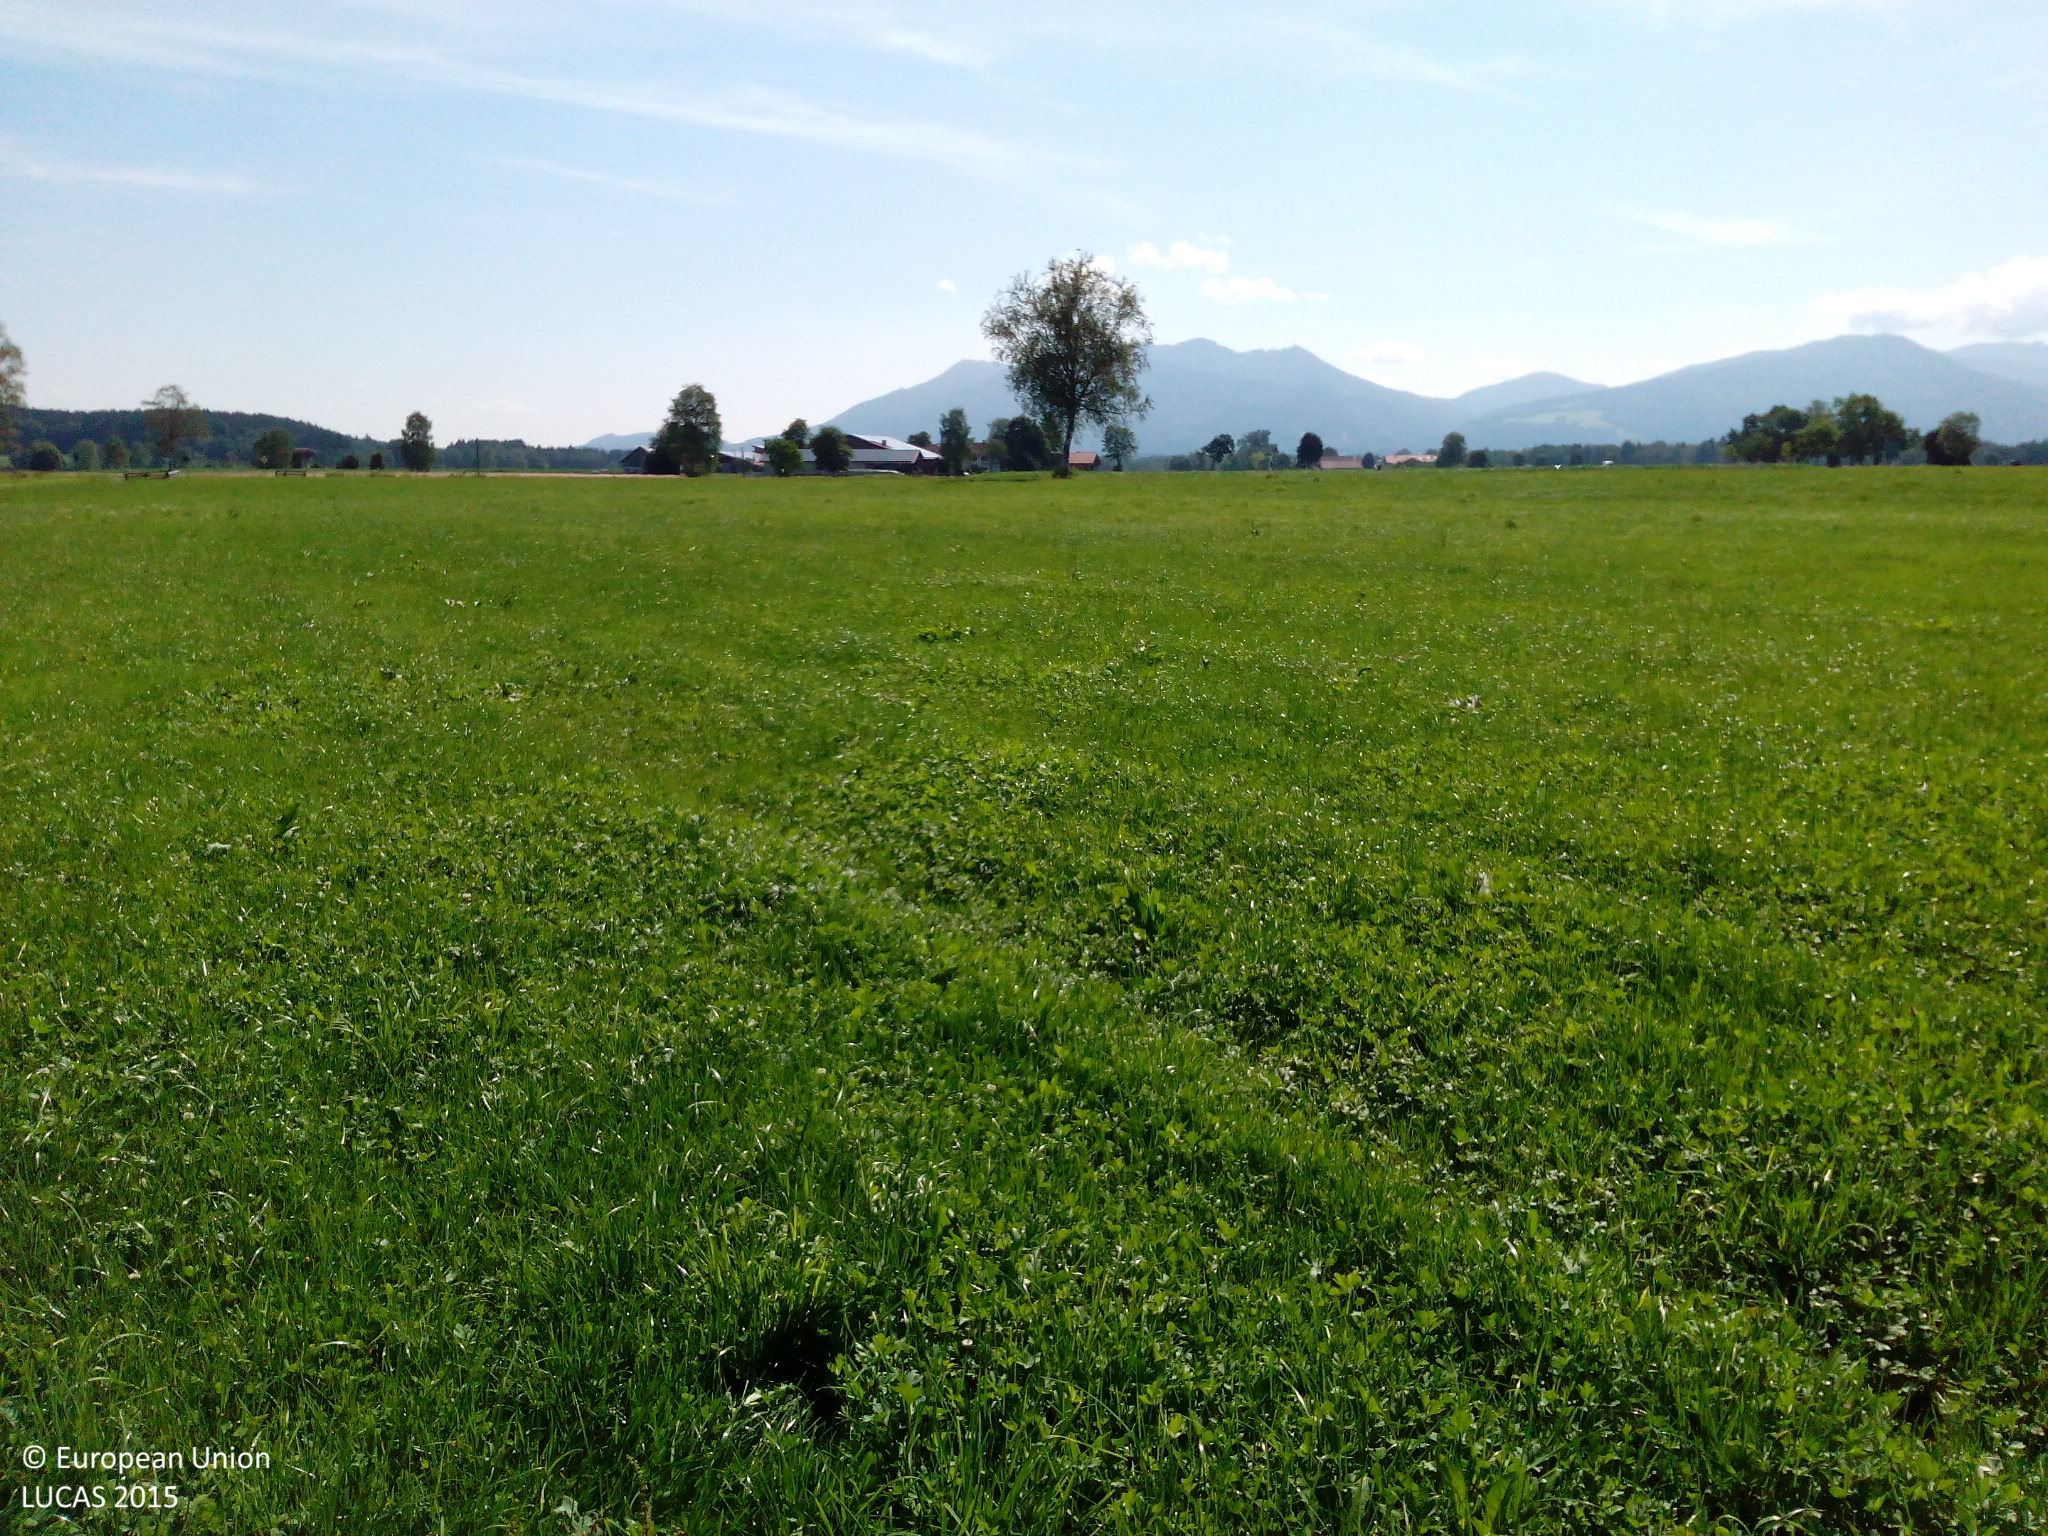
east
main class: Grassland
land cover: Grassland without tree/shrub cover
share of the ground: > 75 %
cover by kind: herbaceous plants 100 %
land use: Agriculture (excluding fallow land and kitchen gardens)
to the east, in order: Grassland without tree/shrub cover; Paved roads, cycling and walking lanes; Single bushes/trees; Grassland without tree/shrub cover
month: July
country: DE
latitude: 47.7293
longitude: 11.3457
